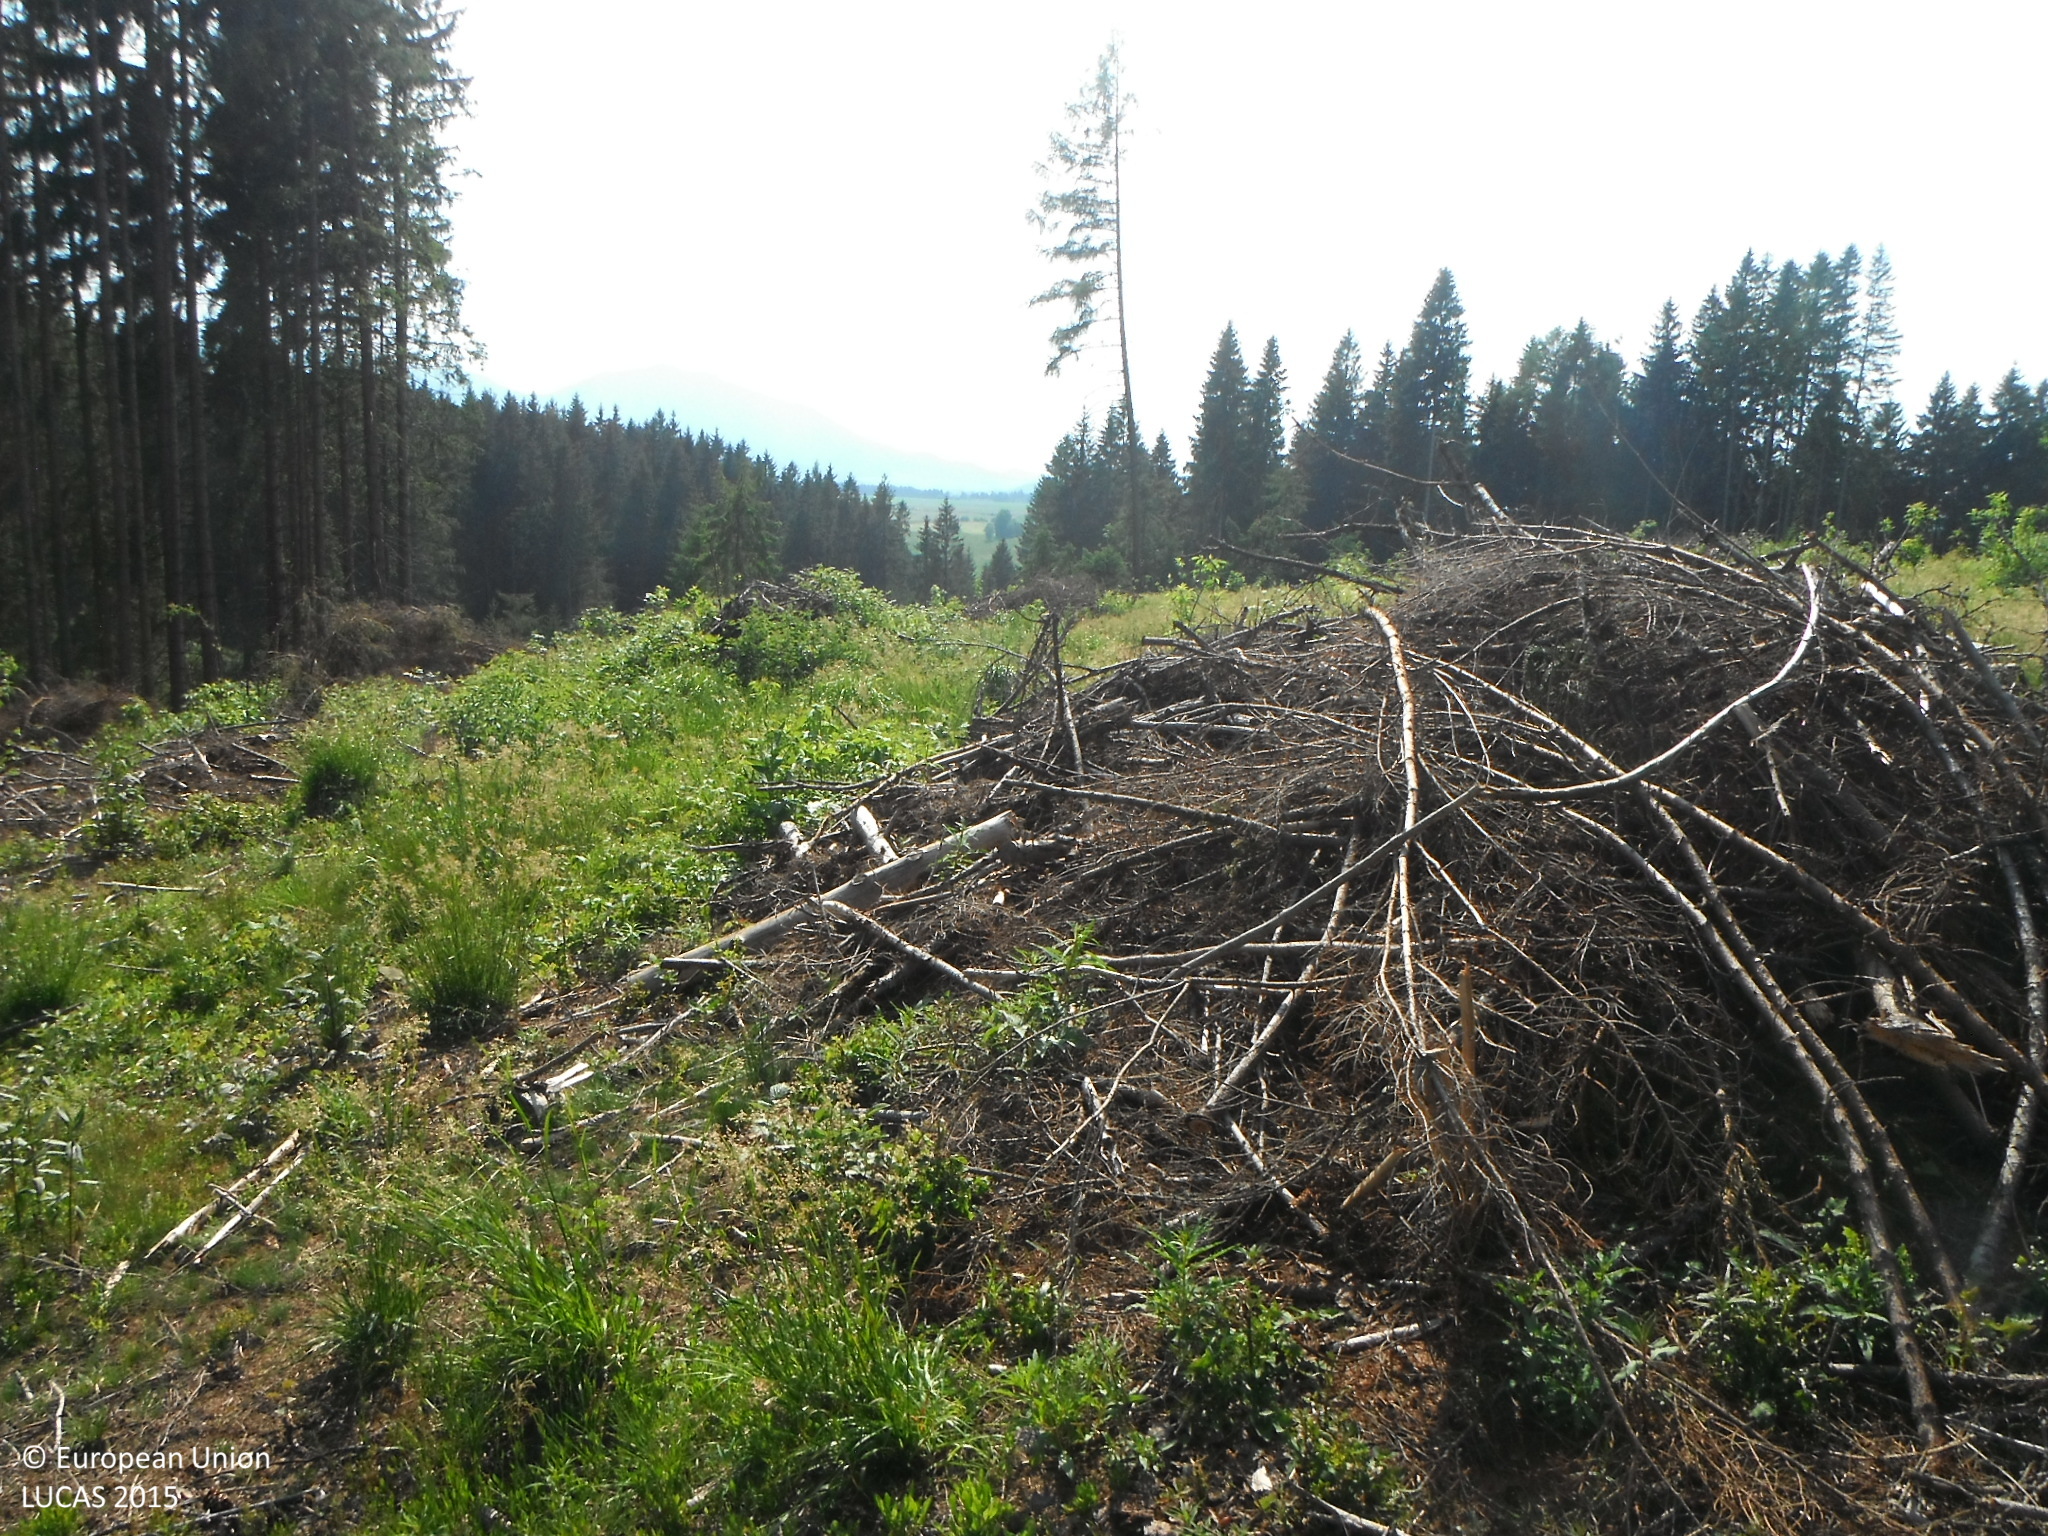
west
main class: Grassland
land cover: Spontaneously vegetated surfaces
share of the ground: > 75 %
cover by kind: herbaceous plants 75 %, unconsolidated bare surface 25 %
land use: Forestry
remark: Clear cut
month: June
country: SK
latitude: 49.0712
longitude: 19.8162
